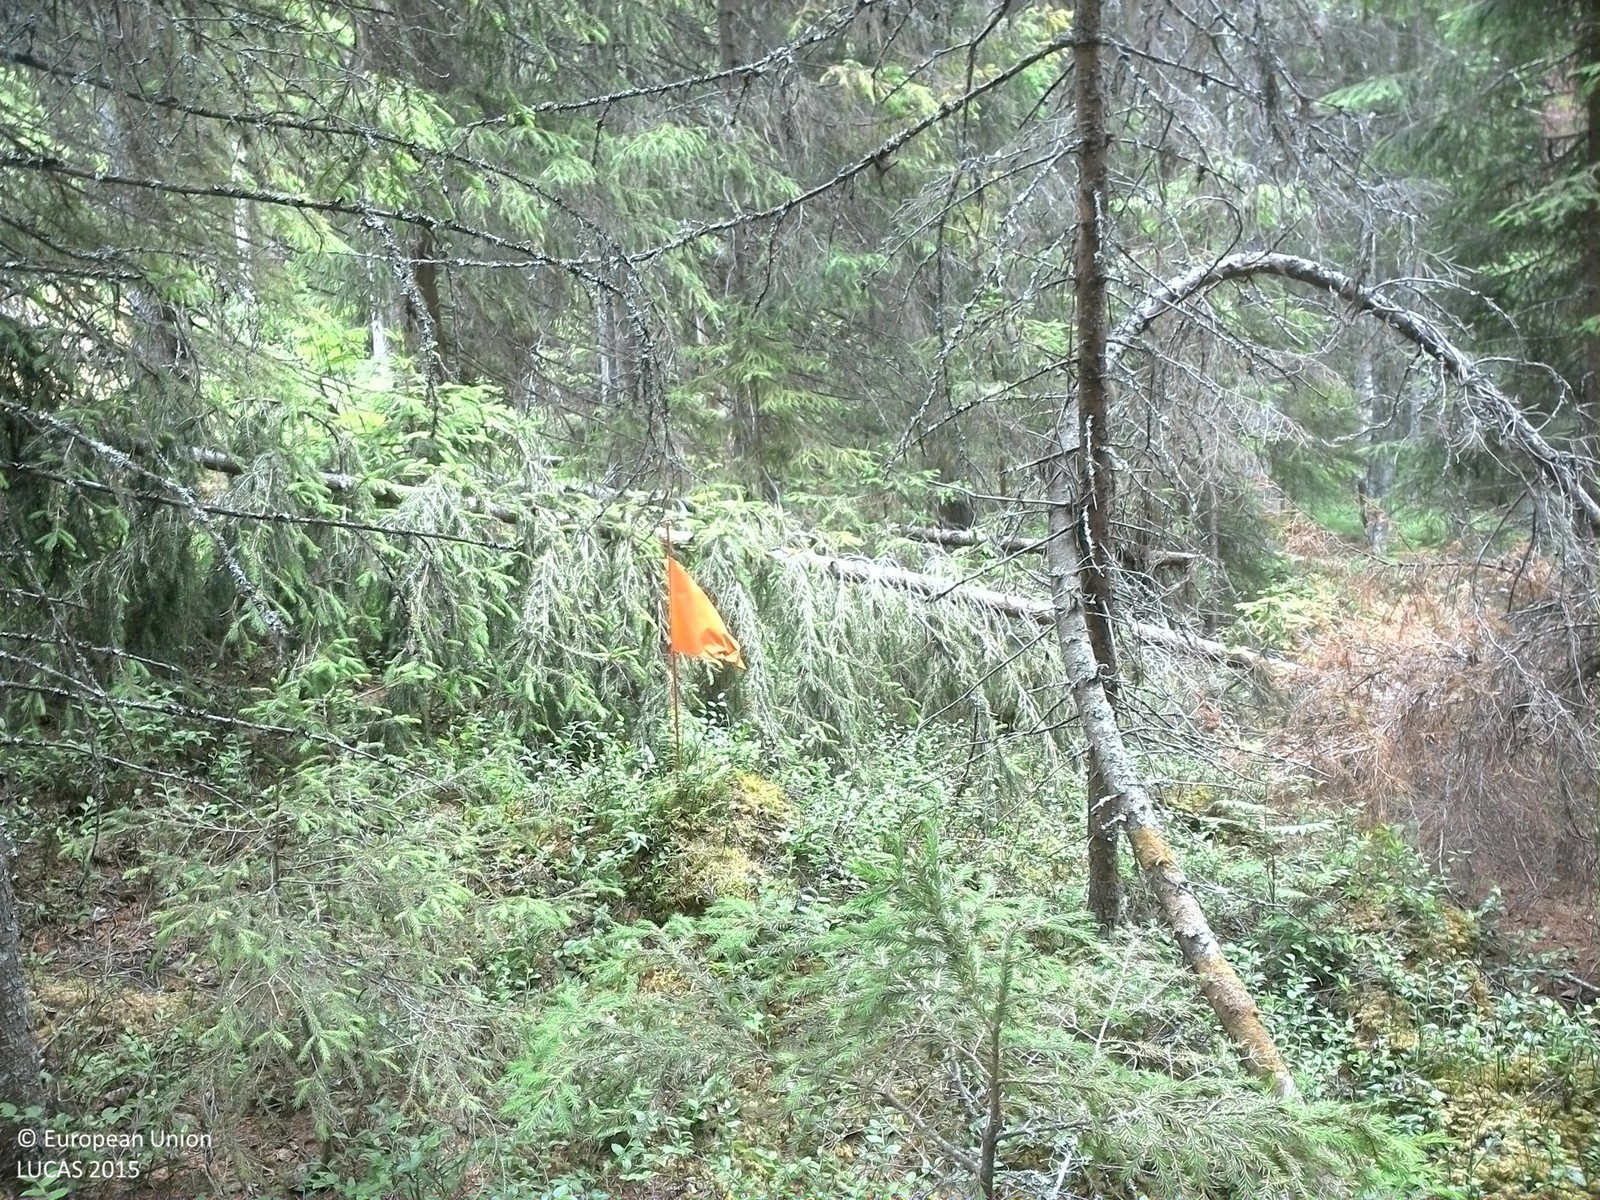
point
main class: Woodland
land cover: Spruce dominated coniferous woodland
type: boreal forest
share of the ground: > 75 %
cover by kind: coniferous forest trees 70 %, shrubs 15 %, lichens and mosses 10 %, broadleaved forest trees 5 %
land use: Forestry
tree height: > 5 m
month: July
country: SE
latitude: 63.5624
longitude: 17.9666
